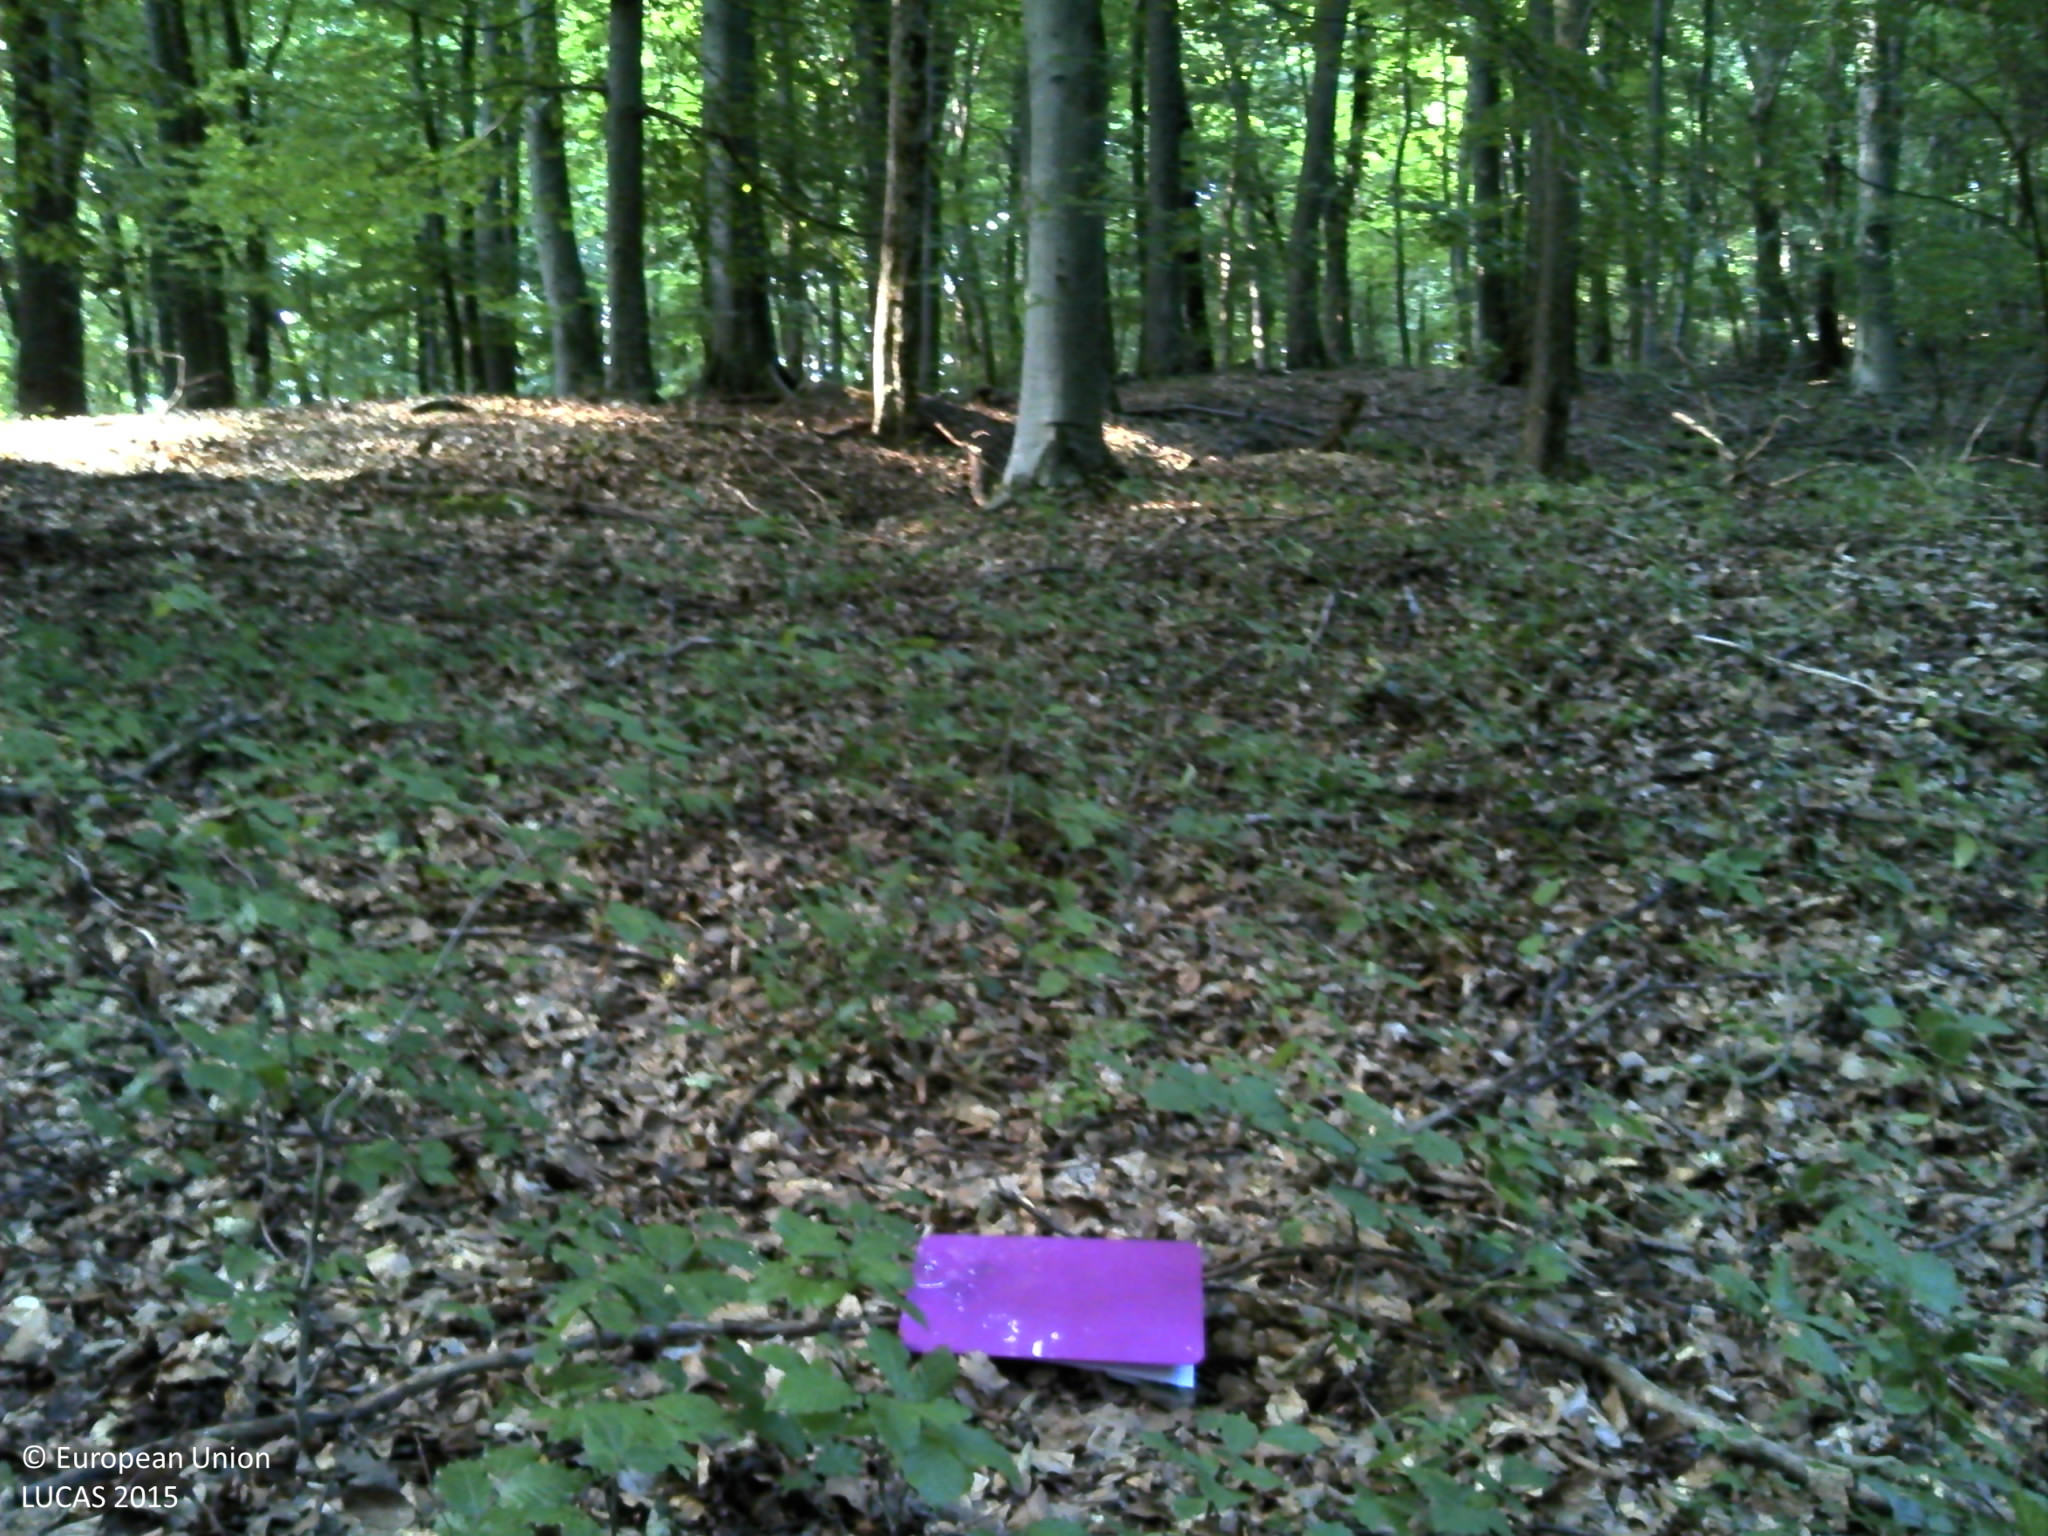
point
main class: Woodland
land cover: Broadleaved woodland
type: beech forest
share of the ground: > 75 %
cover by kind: broadleaved forest trees 100 %
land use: Forestry
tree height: > 5 m
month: July
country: HR
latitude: 45.5973
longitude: 17.2698
